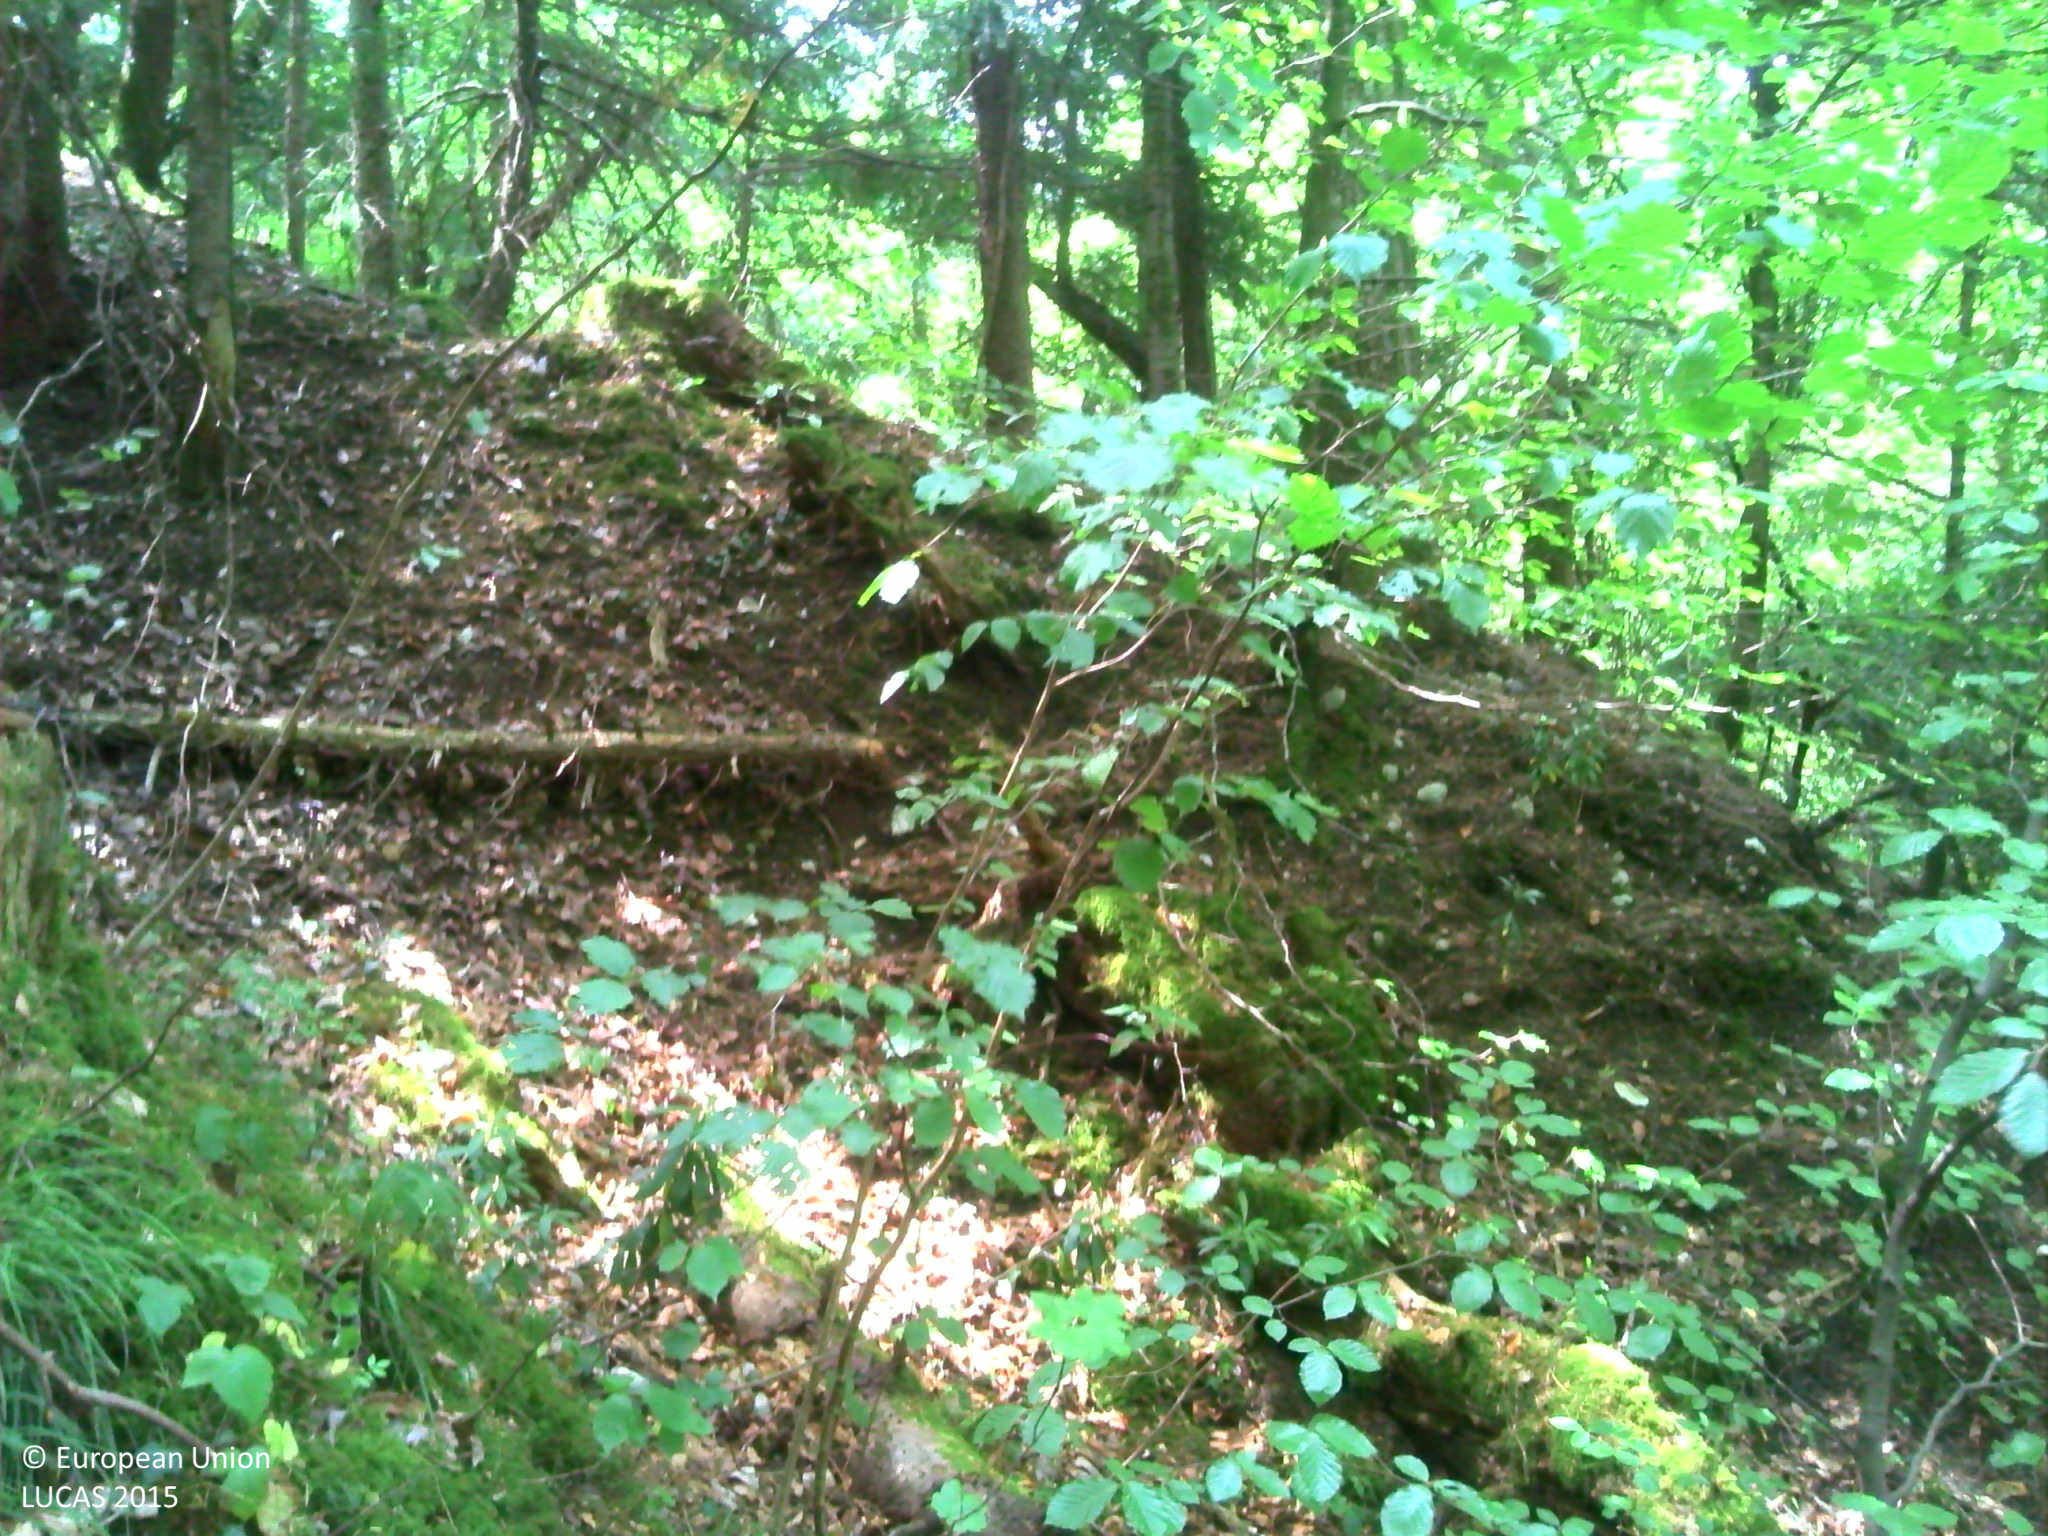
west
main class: Woodland
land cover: Spruce dominated coniferous woodland
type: alpine coniferous forest
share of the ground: > 75 %
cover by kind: coniferous forest trees 60 %, herbaceous plants 20 %, broadleaved forest trees 15 %, lichens and mosses 5 %
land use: Forestry
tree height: > 5 m
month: July
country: FR
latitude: 45.7611
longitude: 6.2113
